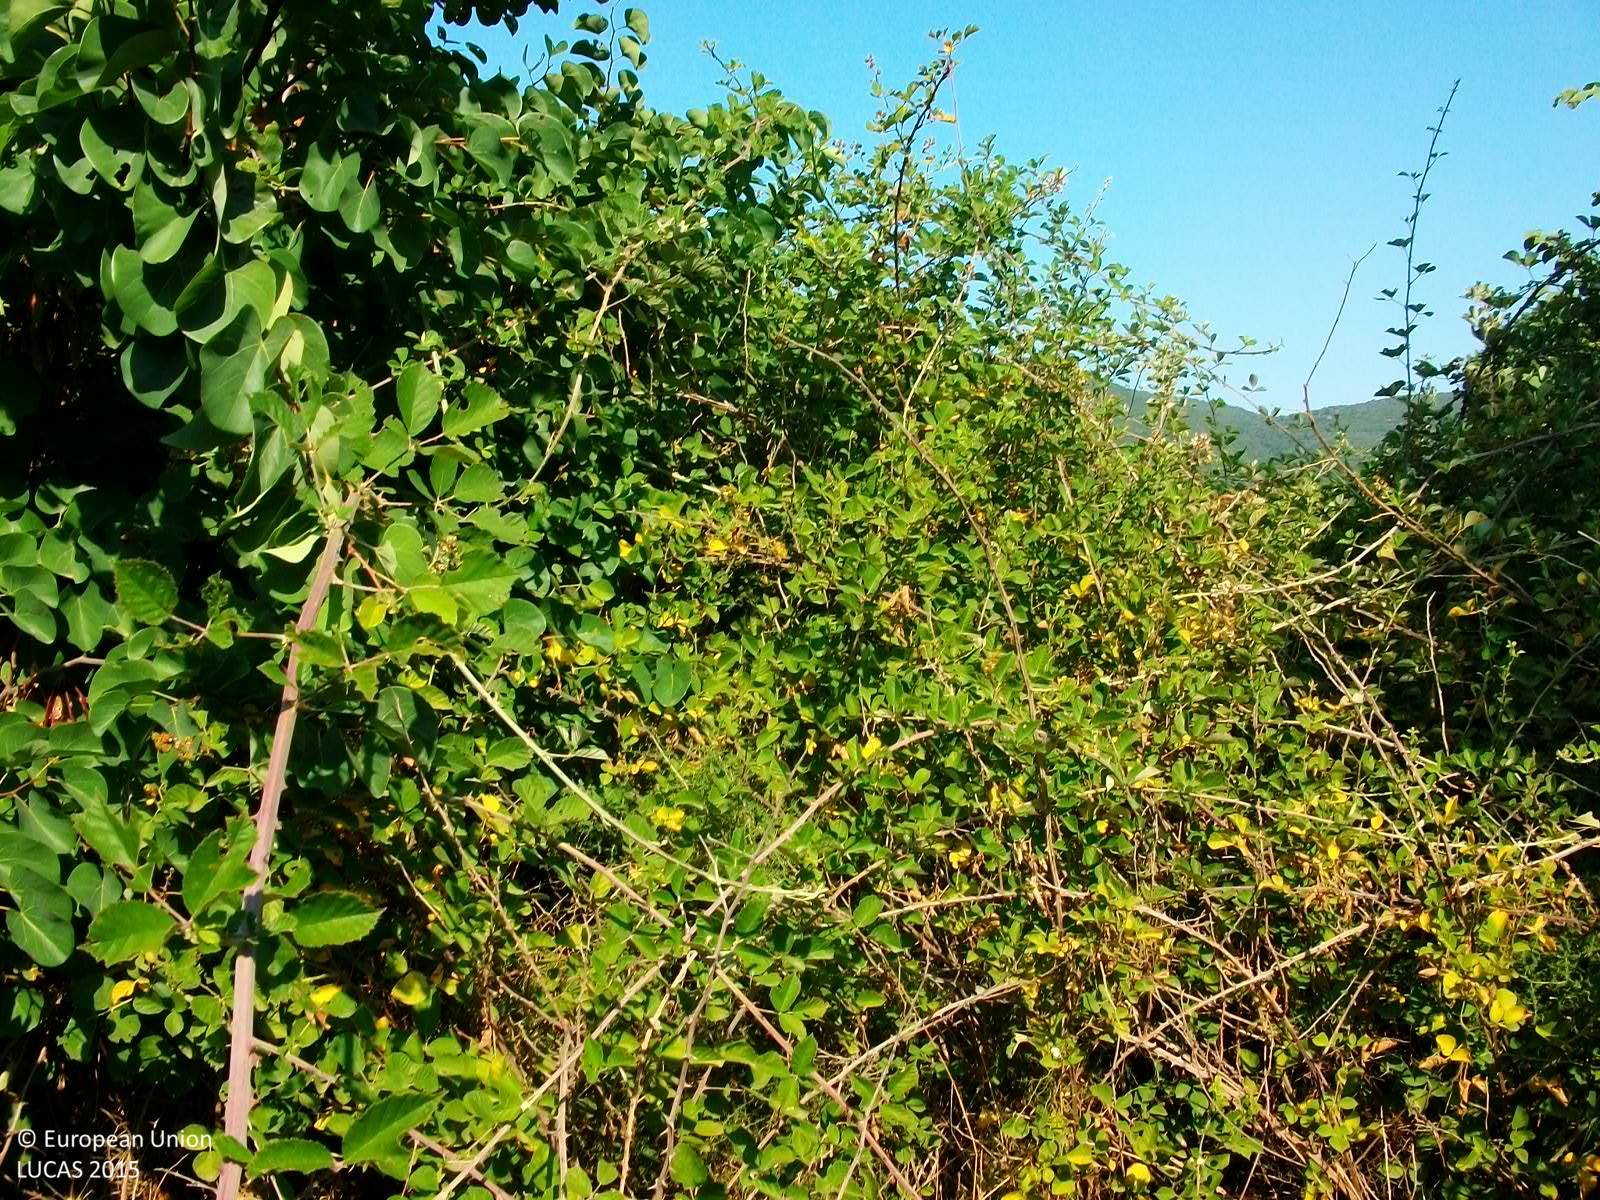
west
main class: Cropland
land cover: Olive groves
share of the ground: 50 - 75 %
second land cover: Spontaneously vegetated surfaces
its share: > 75 %
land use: Agriculture (excluding fallow land and kitchen gardens)
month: July
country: GR
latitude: 37.3233
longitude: 21.9299
